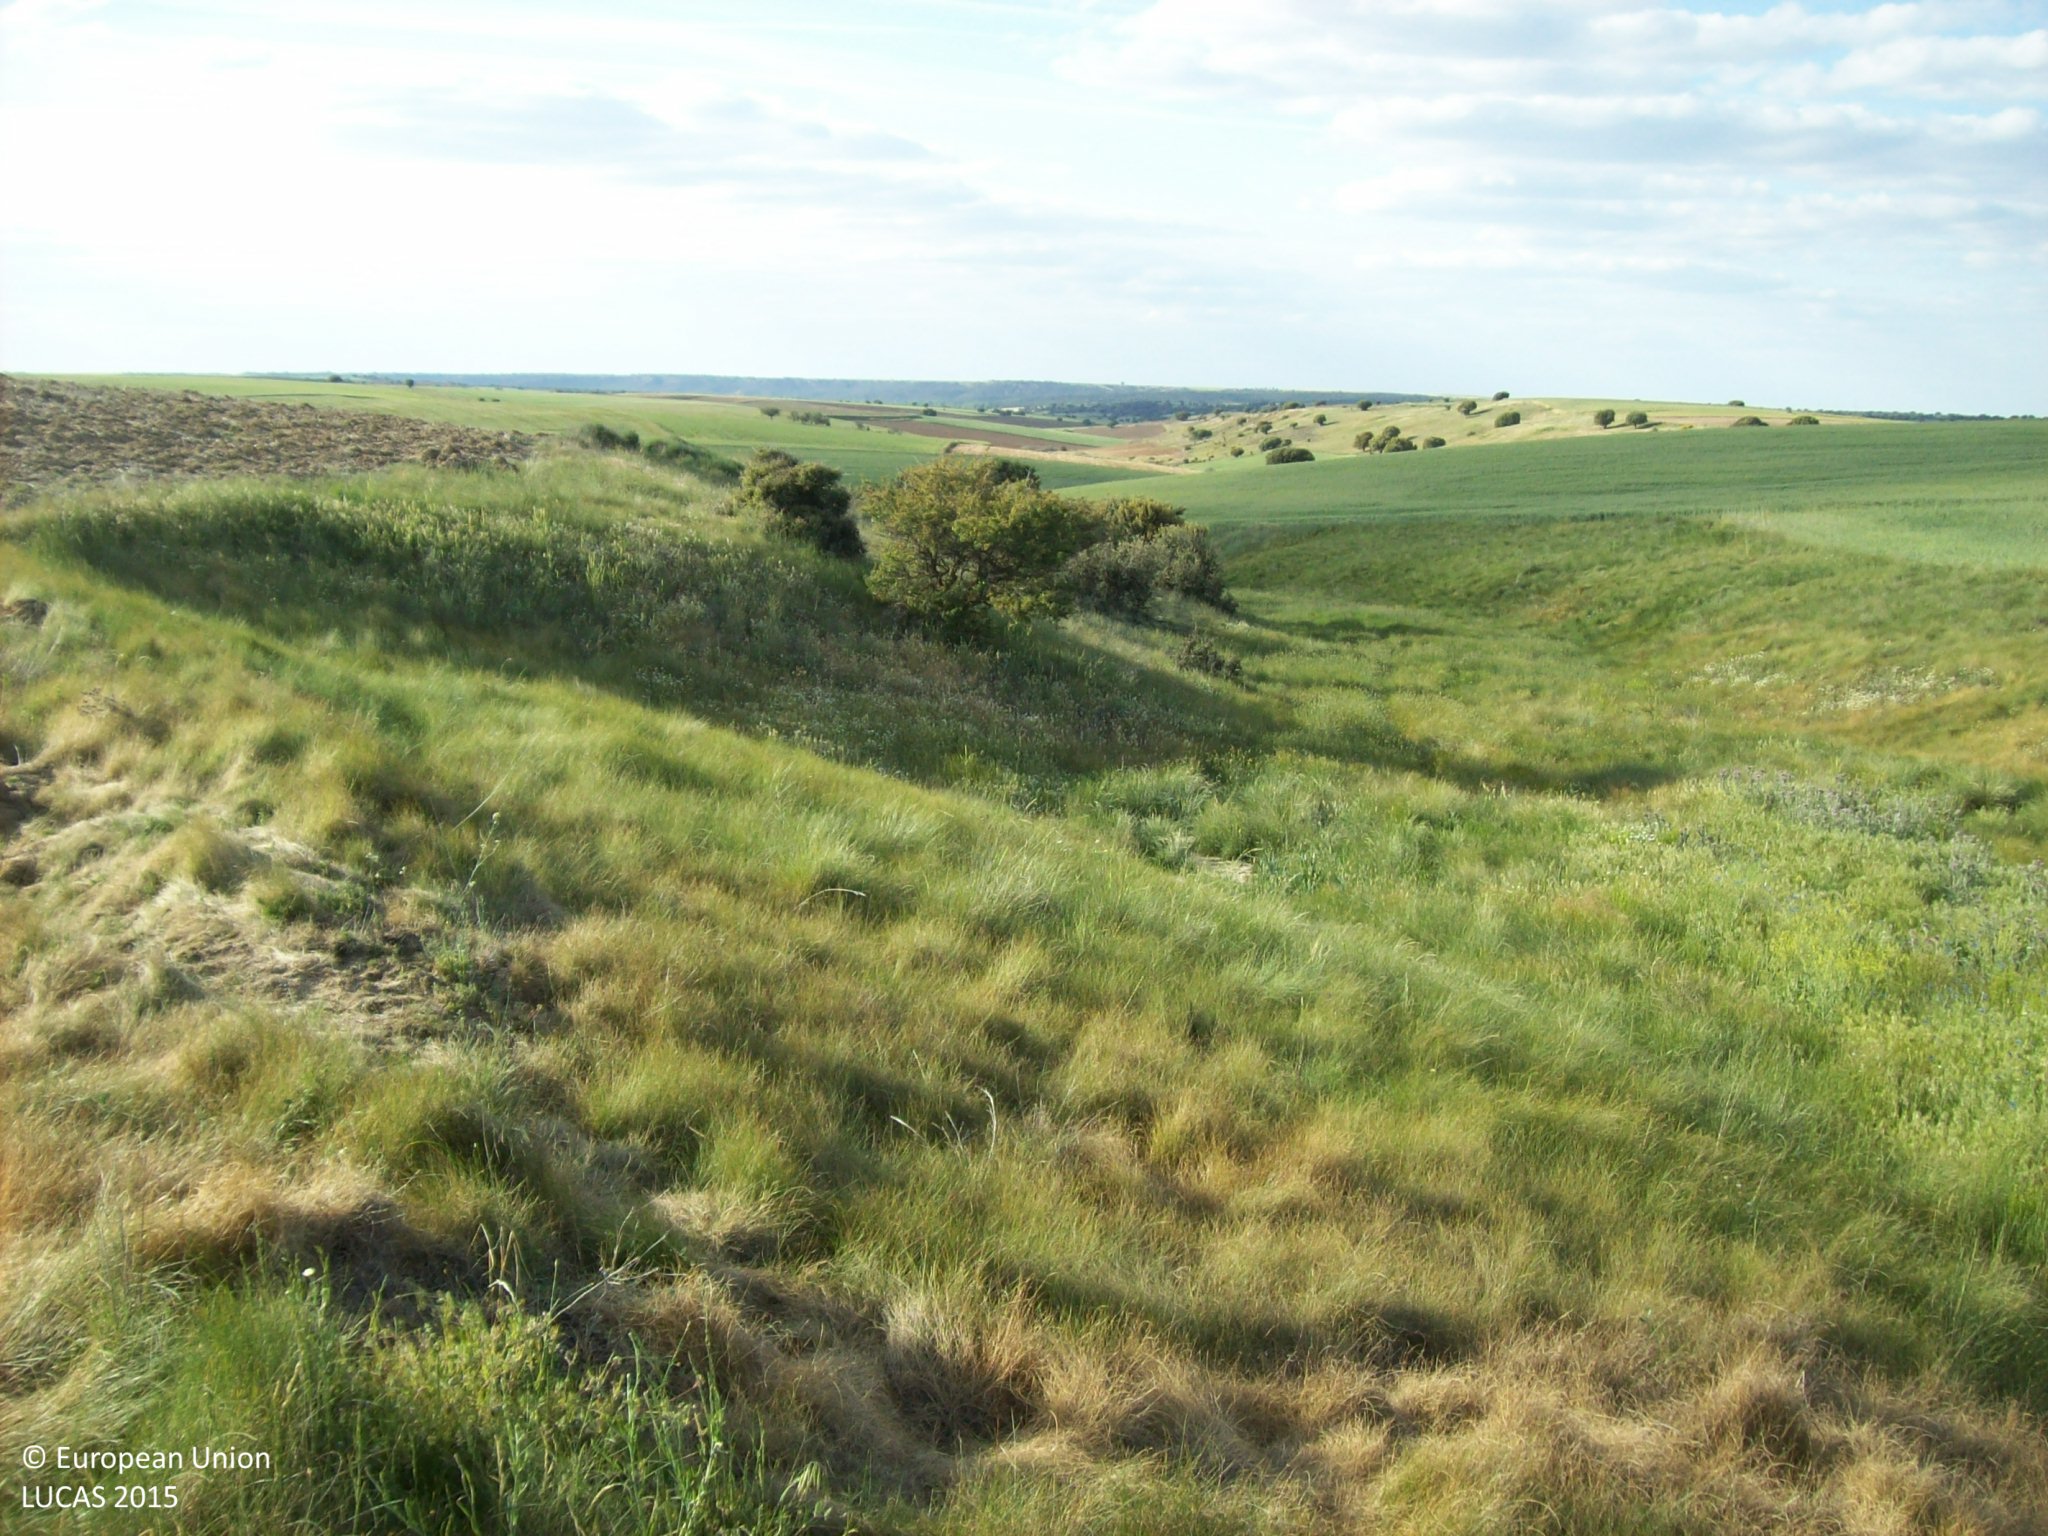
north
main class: Grassland
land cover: Grassland without tree/shrub cover
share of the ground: > 75 %
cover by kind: herbaceous plants 80 %, unconsolidated bare surface 15 %
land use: Semi-natural and natural areas not in use
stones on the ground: < 10 %
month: May
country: ES
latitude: 40.8188
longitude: -4.4831
